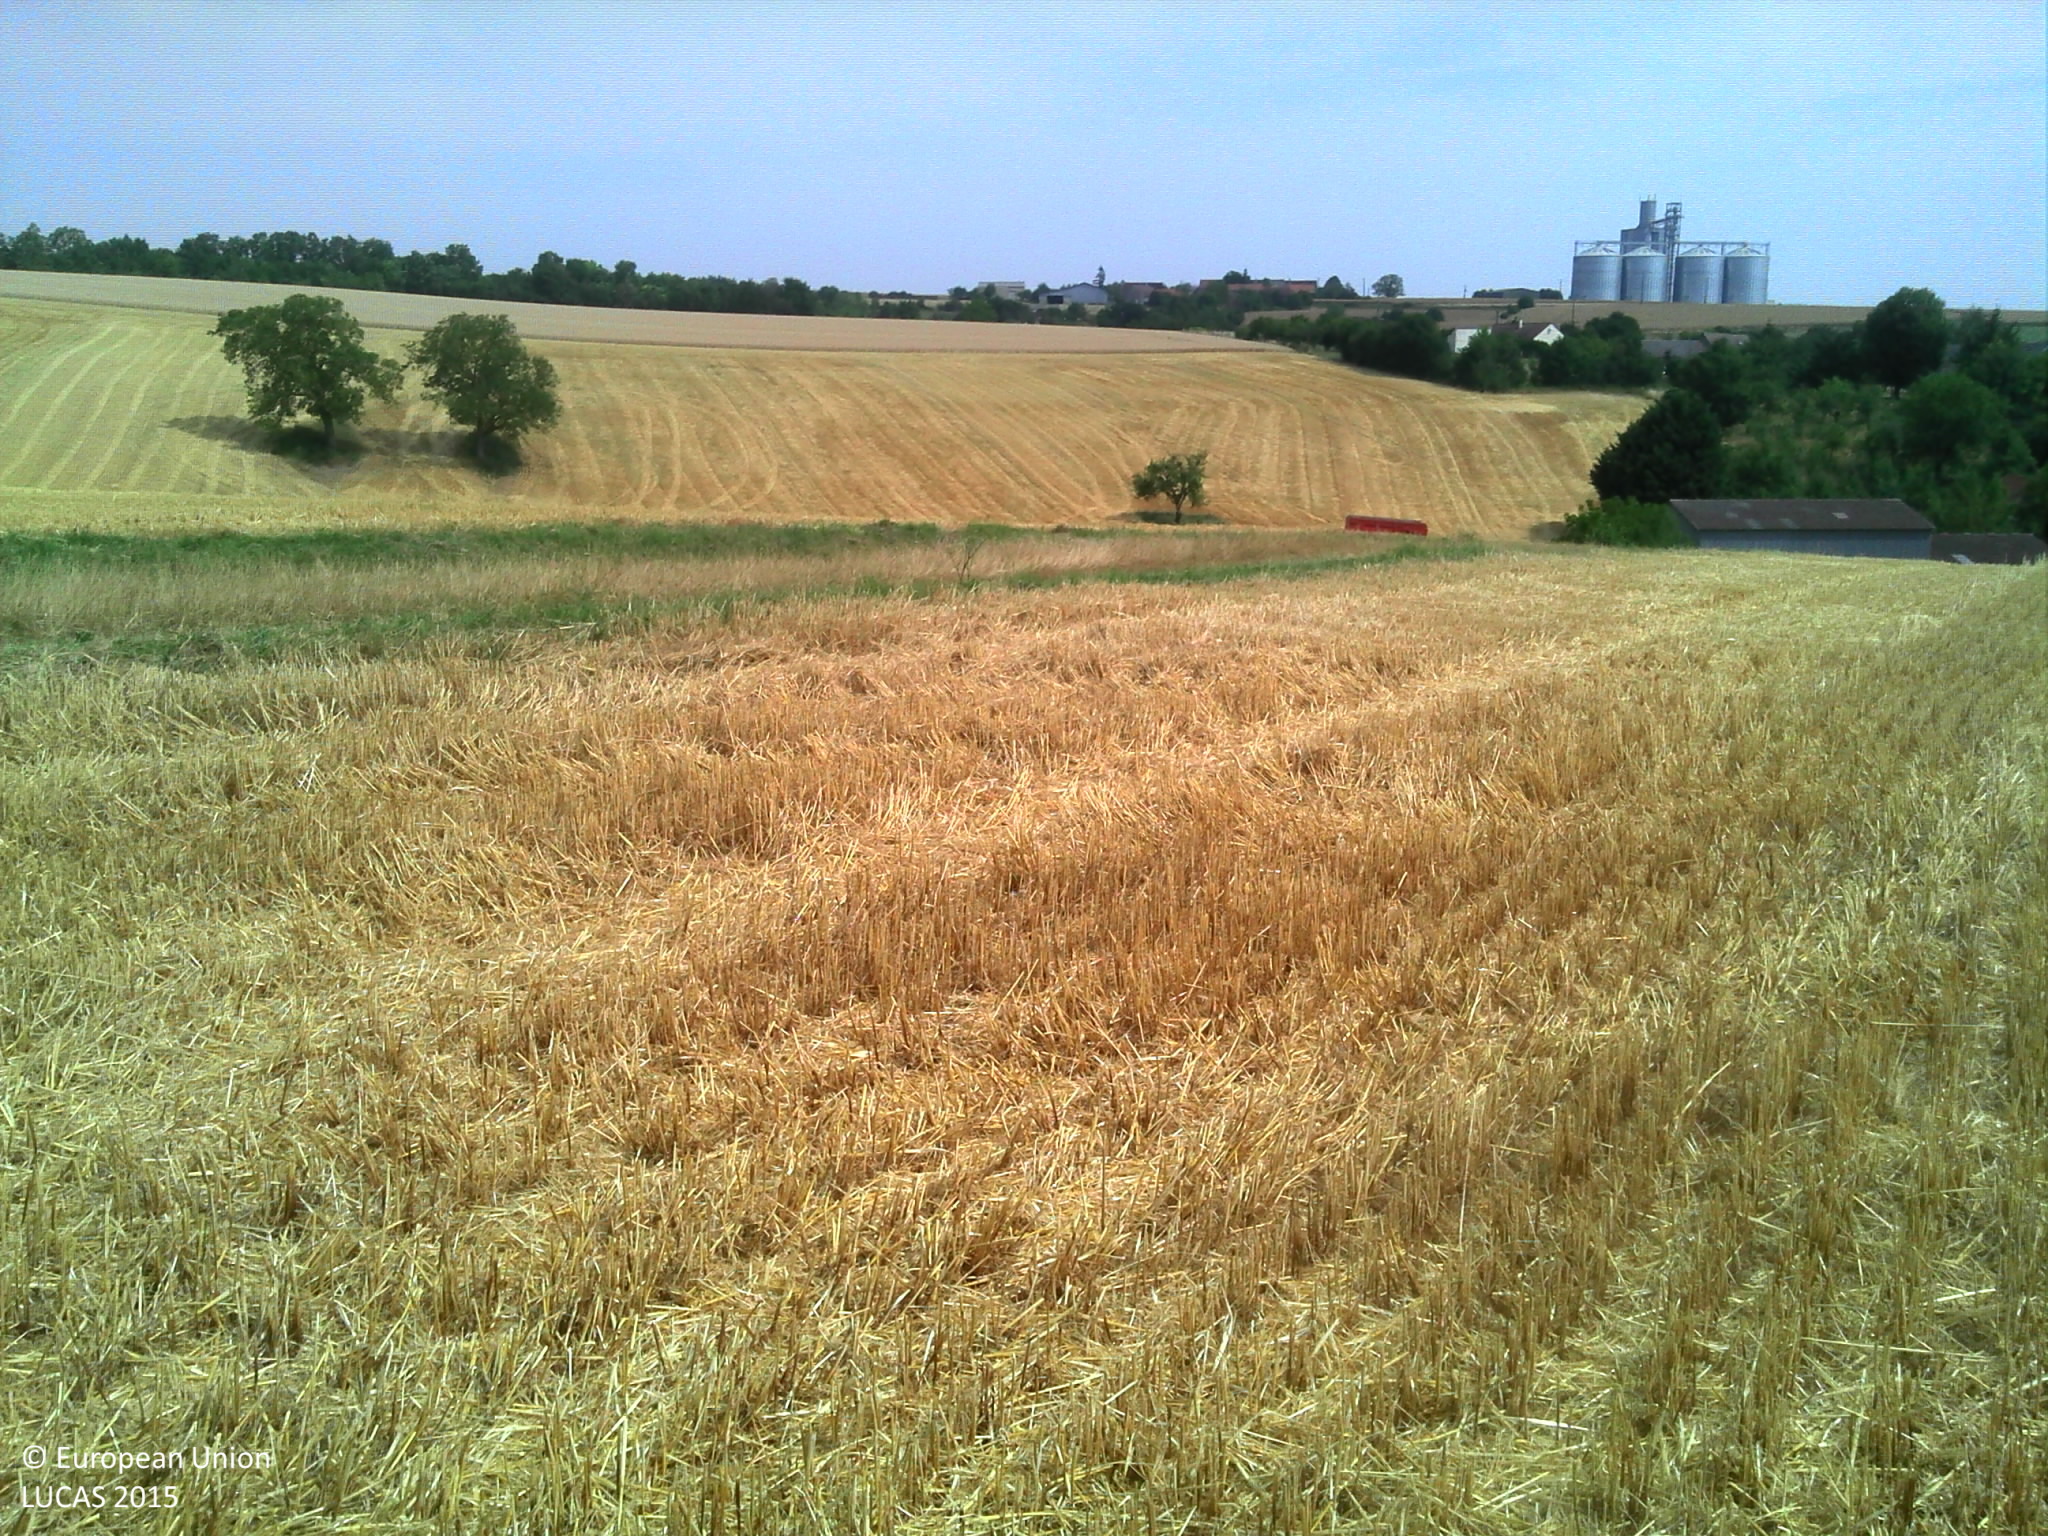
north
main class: Cropland
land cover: Barley
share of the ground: > 75 %
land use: Agriculture (excluding fallow land and kitchen gardens)
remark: Harvested field
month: July
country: FR
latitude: 47.6517
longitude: 3.4855
